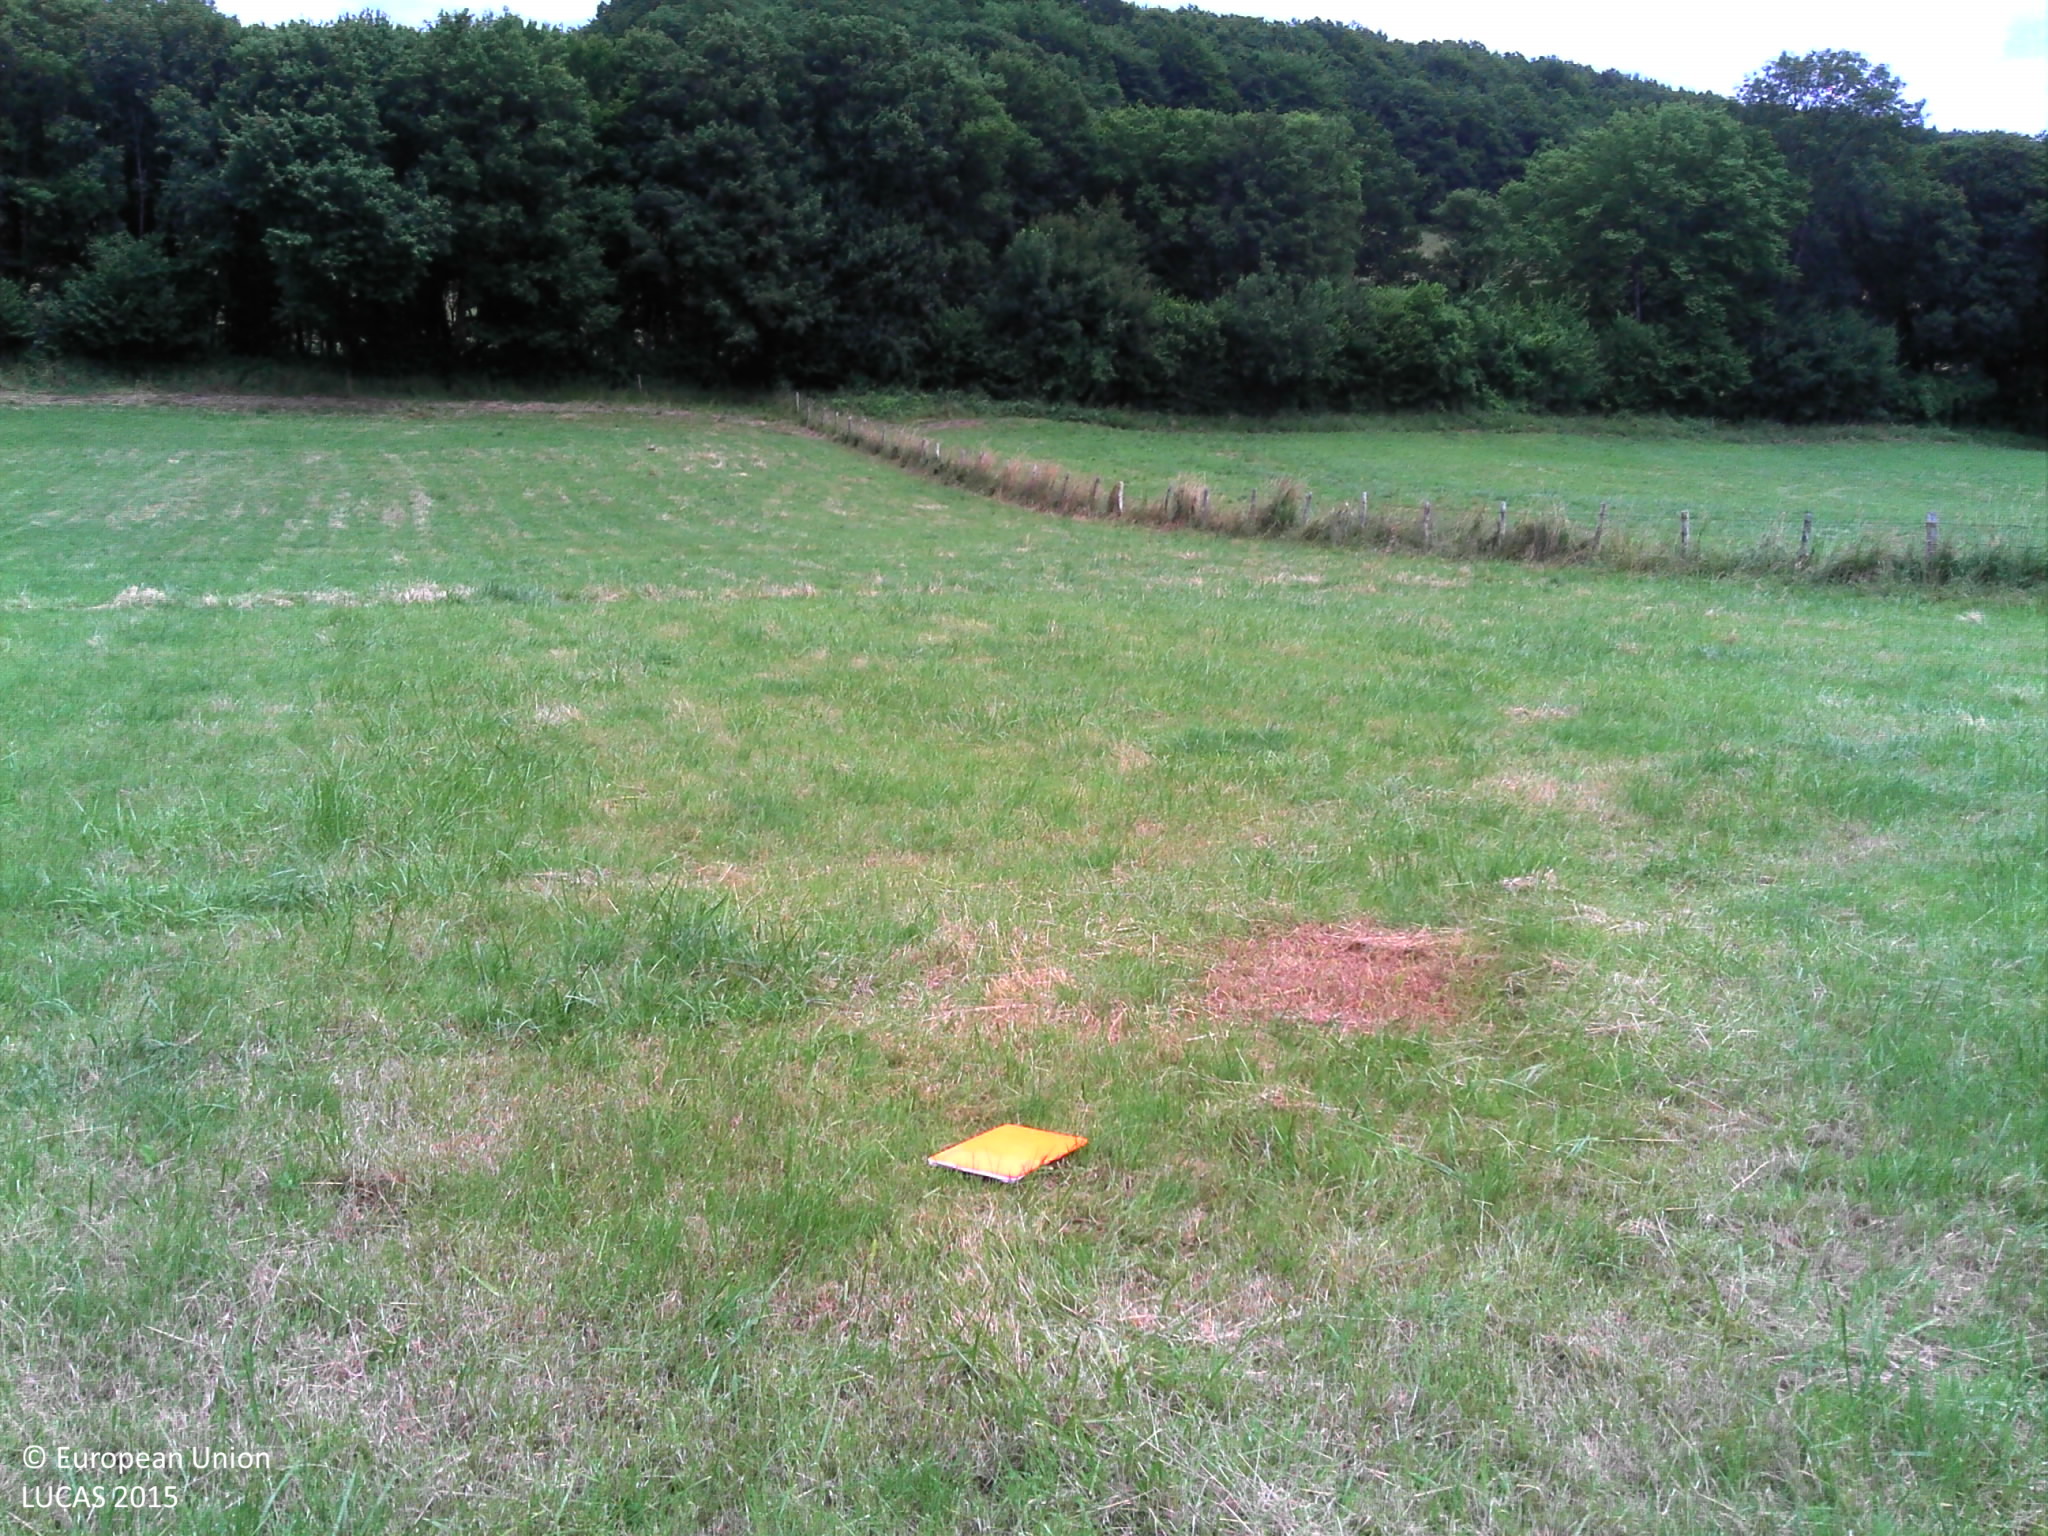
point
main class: Grassland
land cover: Grassland without tree/shrub cover
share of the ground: > 75 %
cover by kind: herbaceous plants 100 %
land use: Agriculture (excluding fallow land and kitchen gardens)
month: June
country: FR
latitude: 47.3277
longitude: 3.2075
